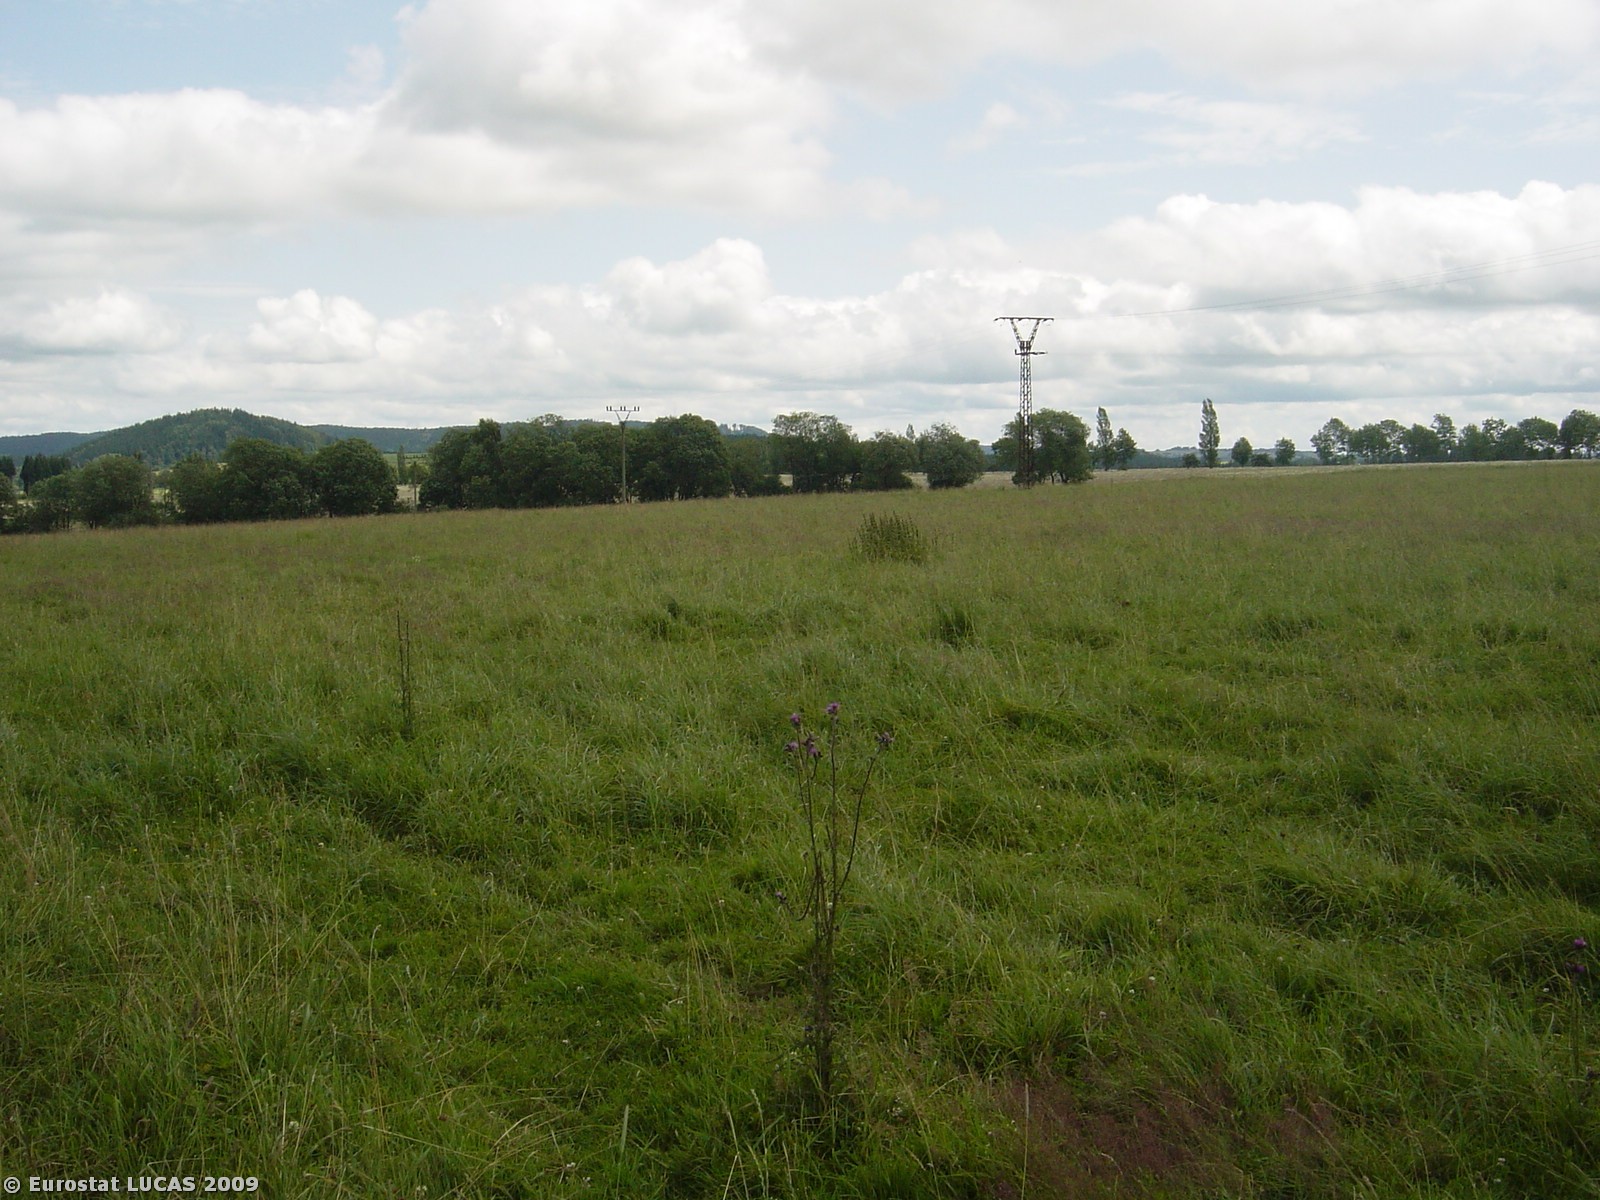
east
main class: Grassland
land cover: Grassland without tree/shrub cover
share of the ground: > 75 %
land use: Agriculture (excluding fallow land and kitchen gardens)
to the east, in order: Grassland without tree/shrub cover; Electric lines; Grassland without tree/shrub cover; Broadleaved woodland; Fences; Grass margins; Paved roads, cycling and walking lanes
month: July
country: CZ
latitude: 50.0030
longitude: 12.9158
